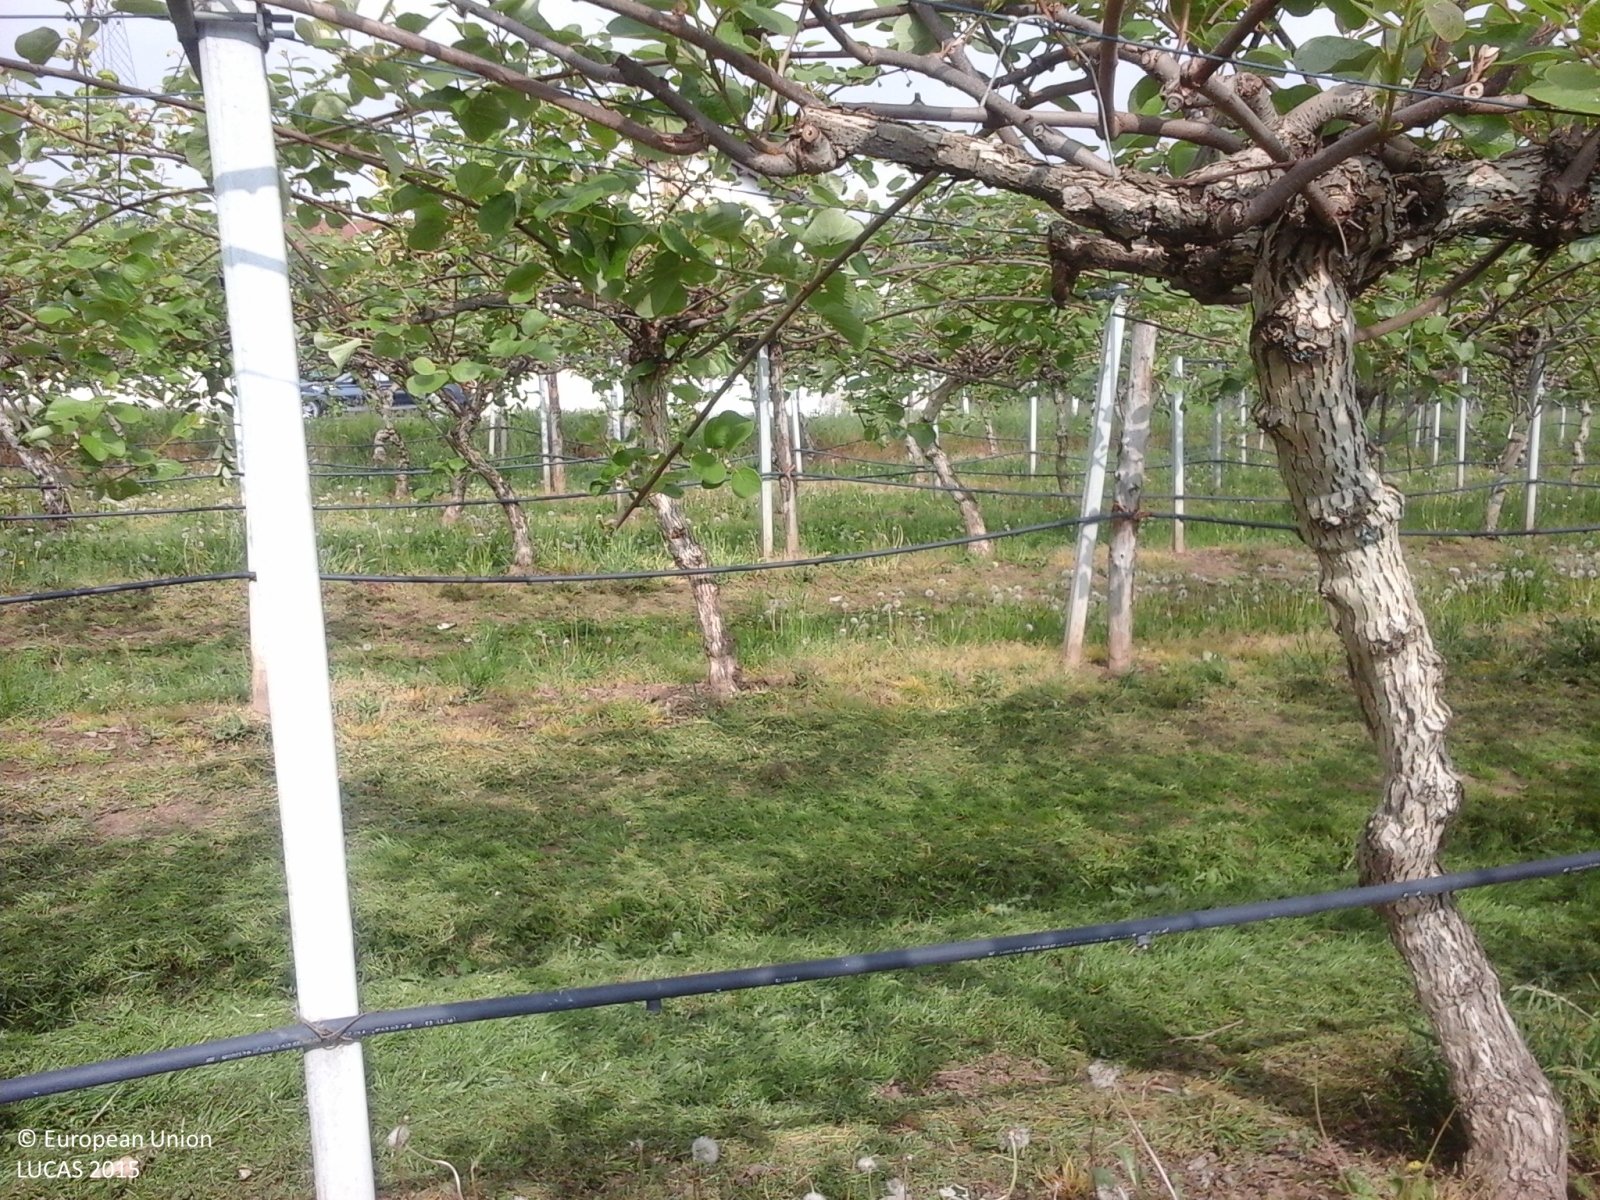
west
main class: Cropland
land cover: Other fruit trees and berries
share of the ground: 50 - 75 %
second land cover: Grassland without tree/shrub cover
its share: 50 - 75 %
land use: Agriculture (excluding fallow land and kitchen gardens)
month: May
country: IT
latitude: 44.5788
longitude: 7.7502
